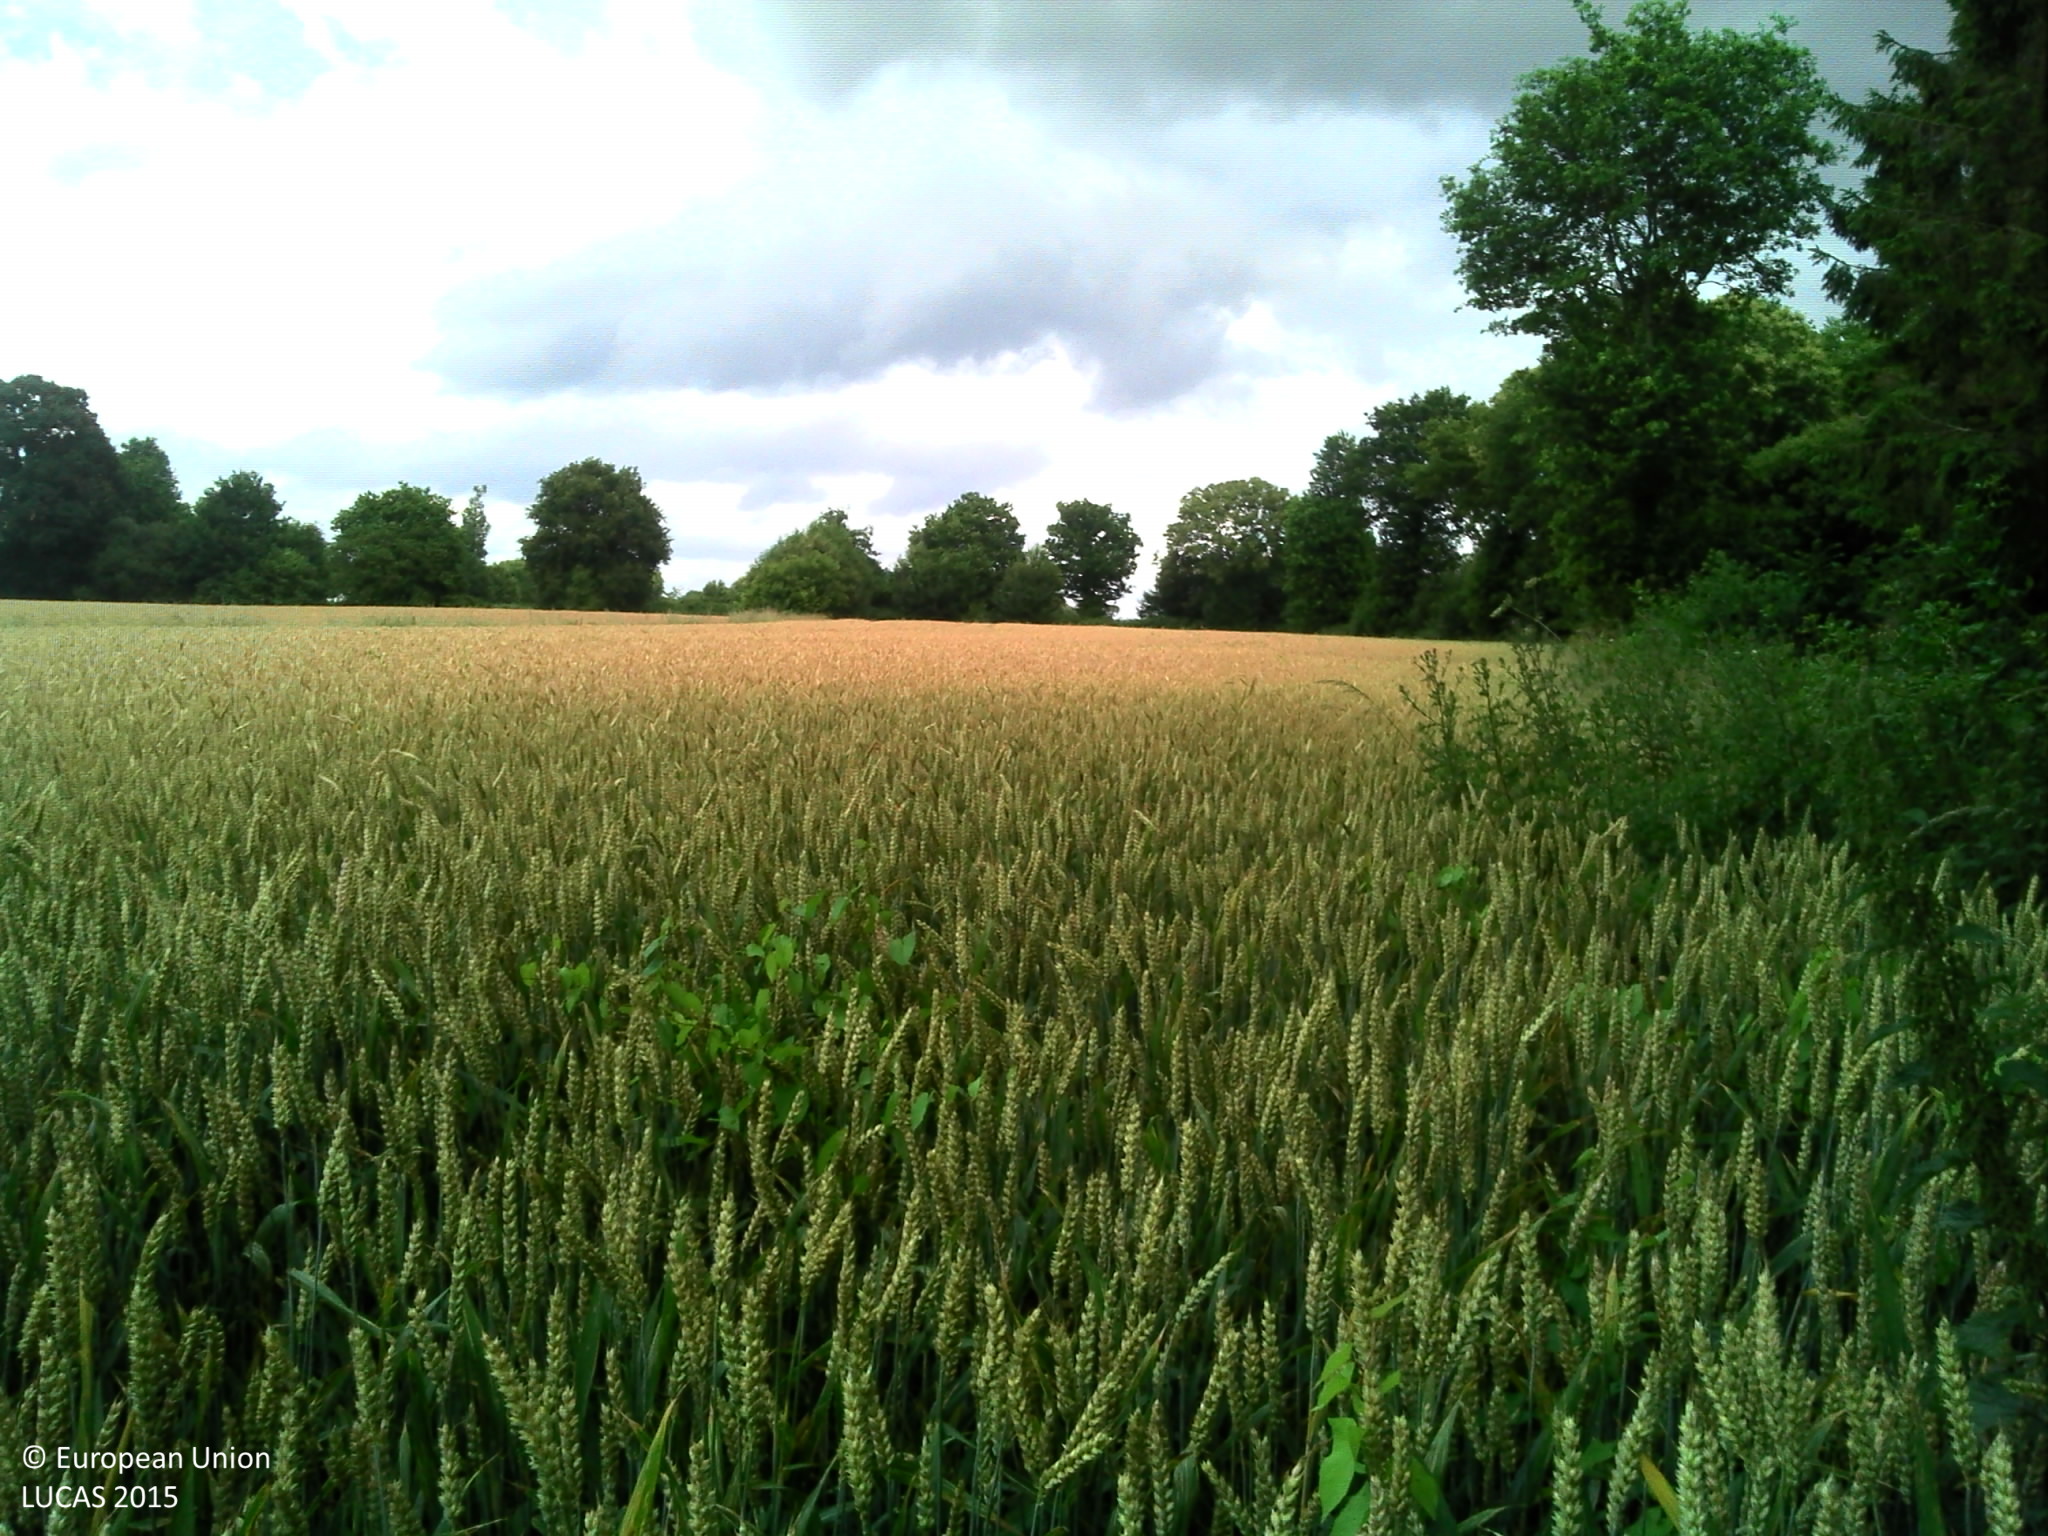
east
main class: Cropland
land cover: Common wheat
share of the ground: > 75 %
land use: Agriculture (excluding fallow land and kitchen gardens)
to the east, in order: Common wheat; Broadleaved woodland; Maize; Electric lines; Maize
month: July
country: FR
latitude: 48.2418
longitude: -2.1336
